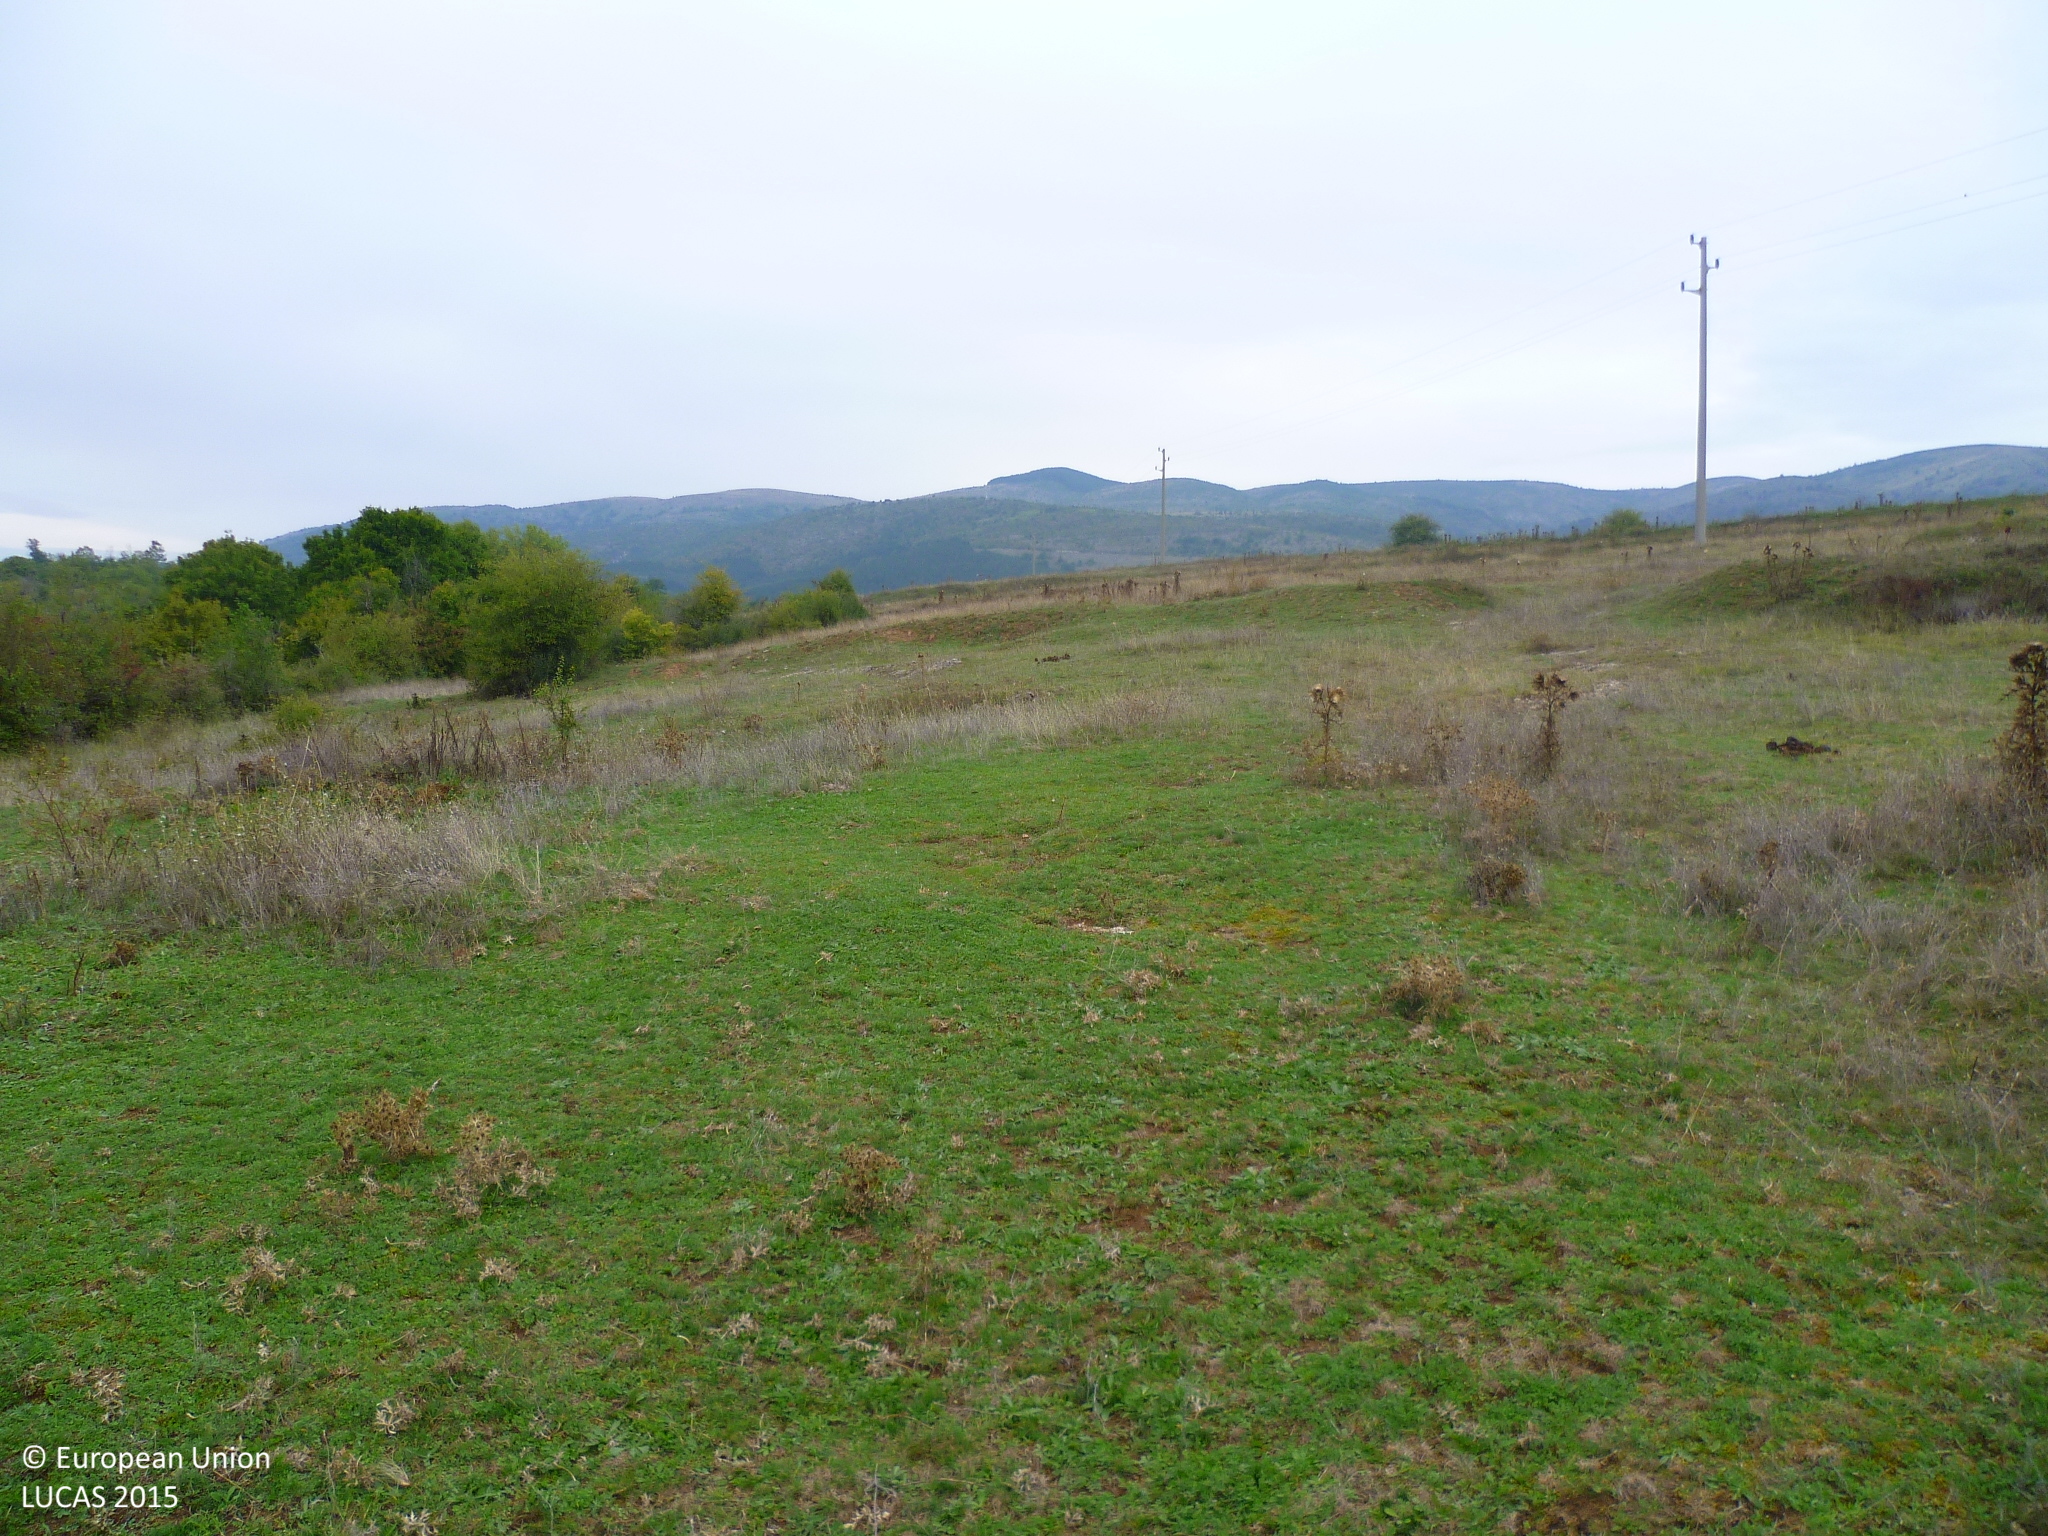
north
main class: Grassland
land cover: Grassland without tree/shrub cover
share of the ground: > 75 %
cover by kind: herbaceous plants 100 %
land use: Agriculture (excluding fallow land and kitchen gardens)
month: October
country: BG
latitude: 43.0143
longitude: 23.0266
